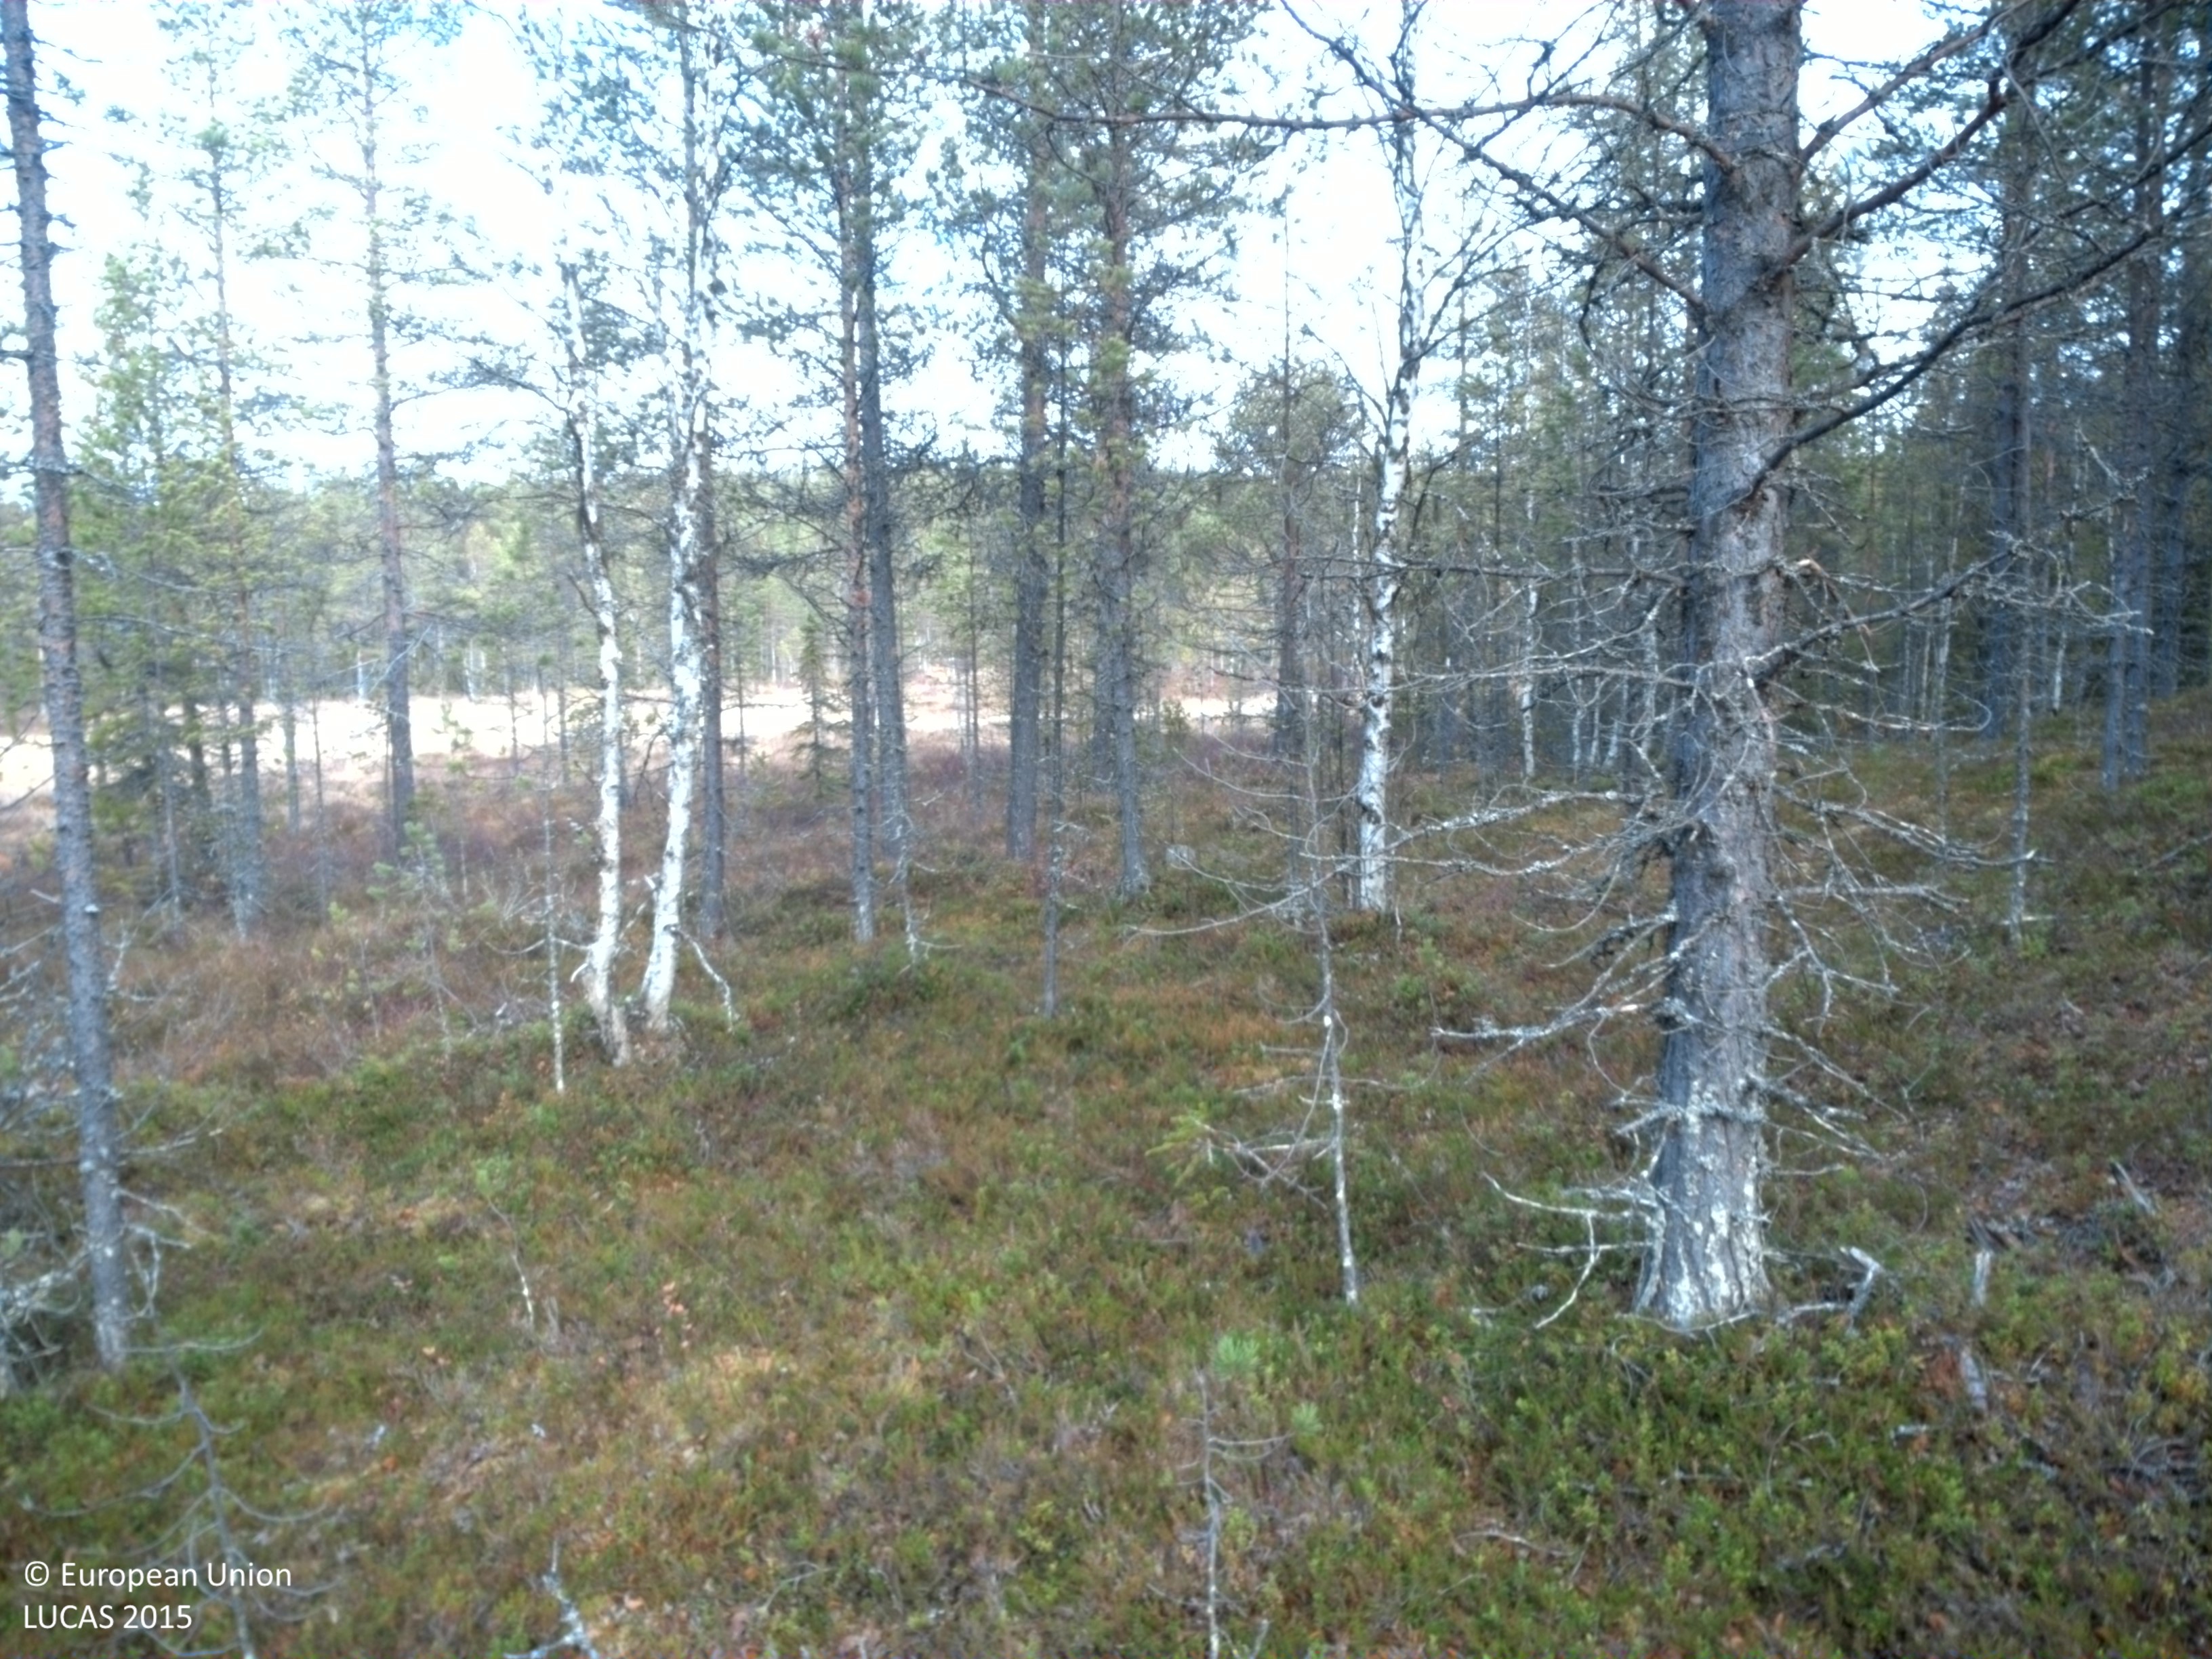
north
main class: Woodland
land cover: Pine dominated coniferous woodland
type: boreal forest
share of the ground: 25 - 50 %
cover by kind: shrubs 45 %, coniferous forest trees 30 %, lichens and mosses 15 %, broadleaved forest trees 5 %, herbaceous plants 5 %
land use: Forestry
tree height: > 5 m
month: October
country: SE
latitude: 64.6329
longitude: 16.8075
